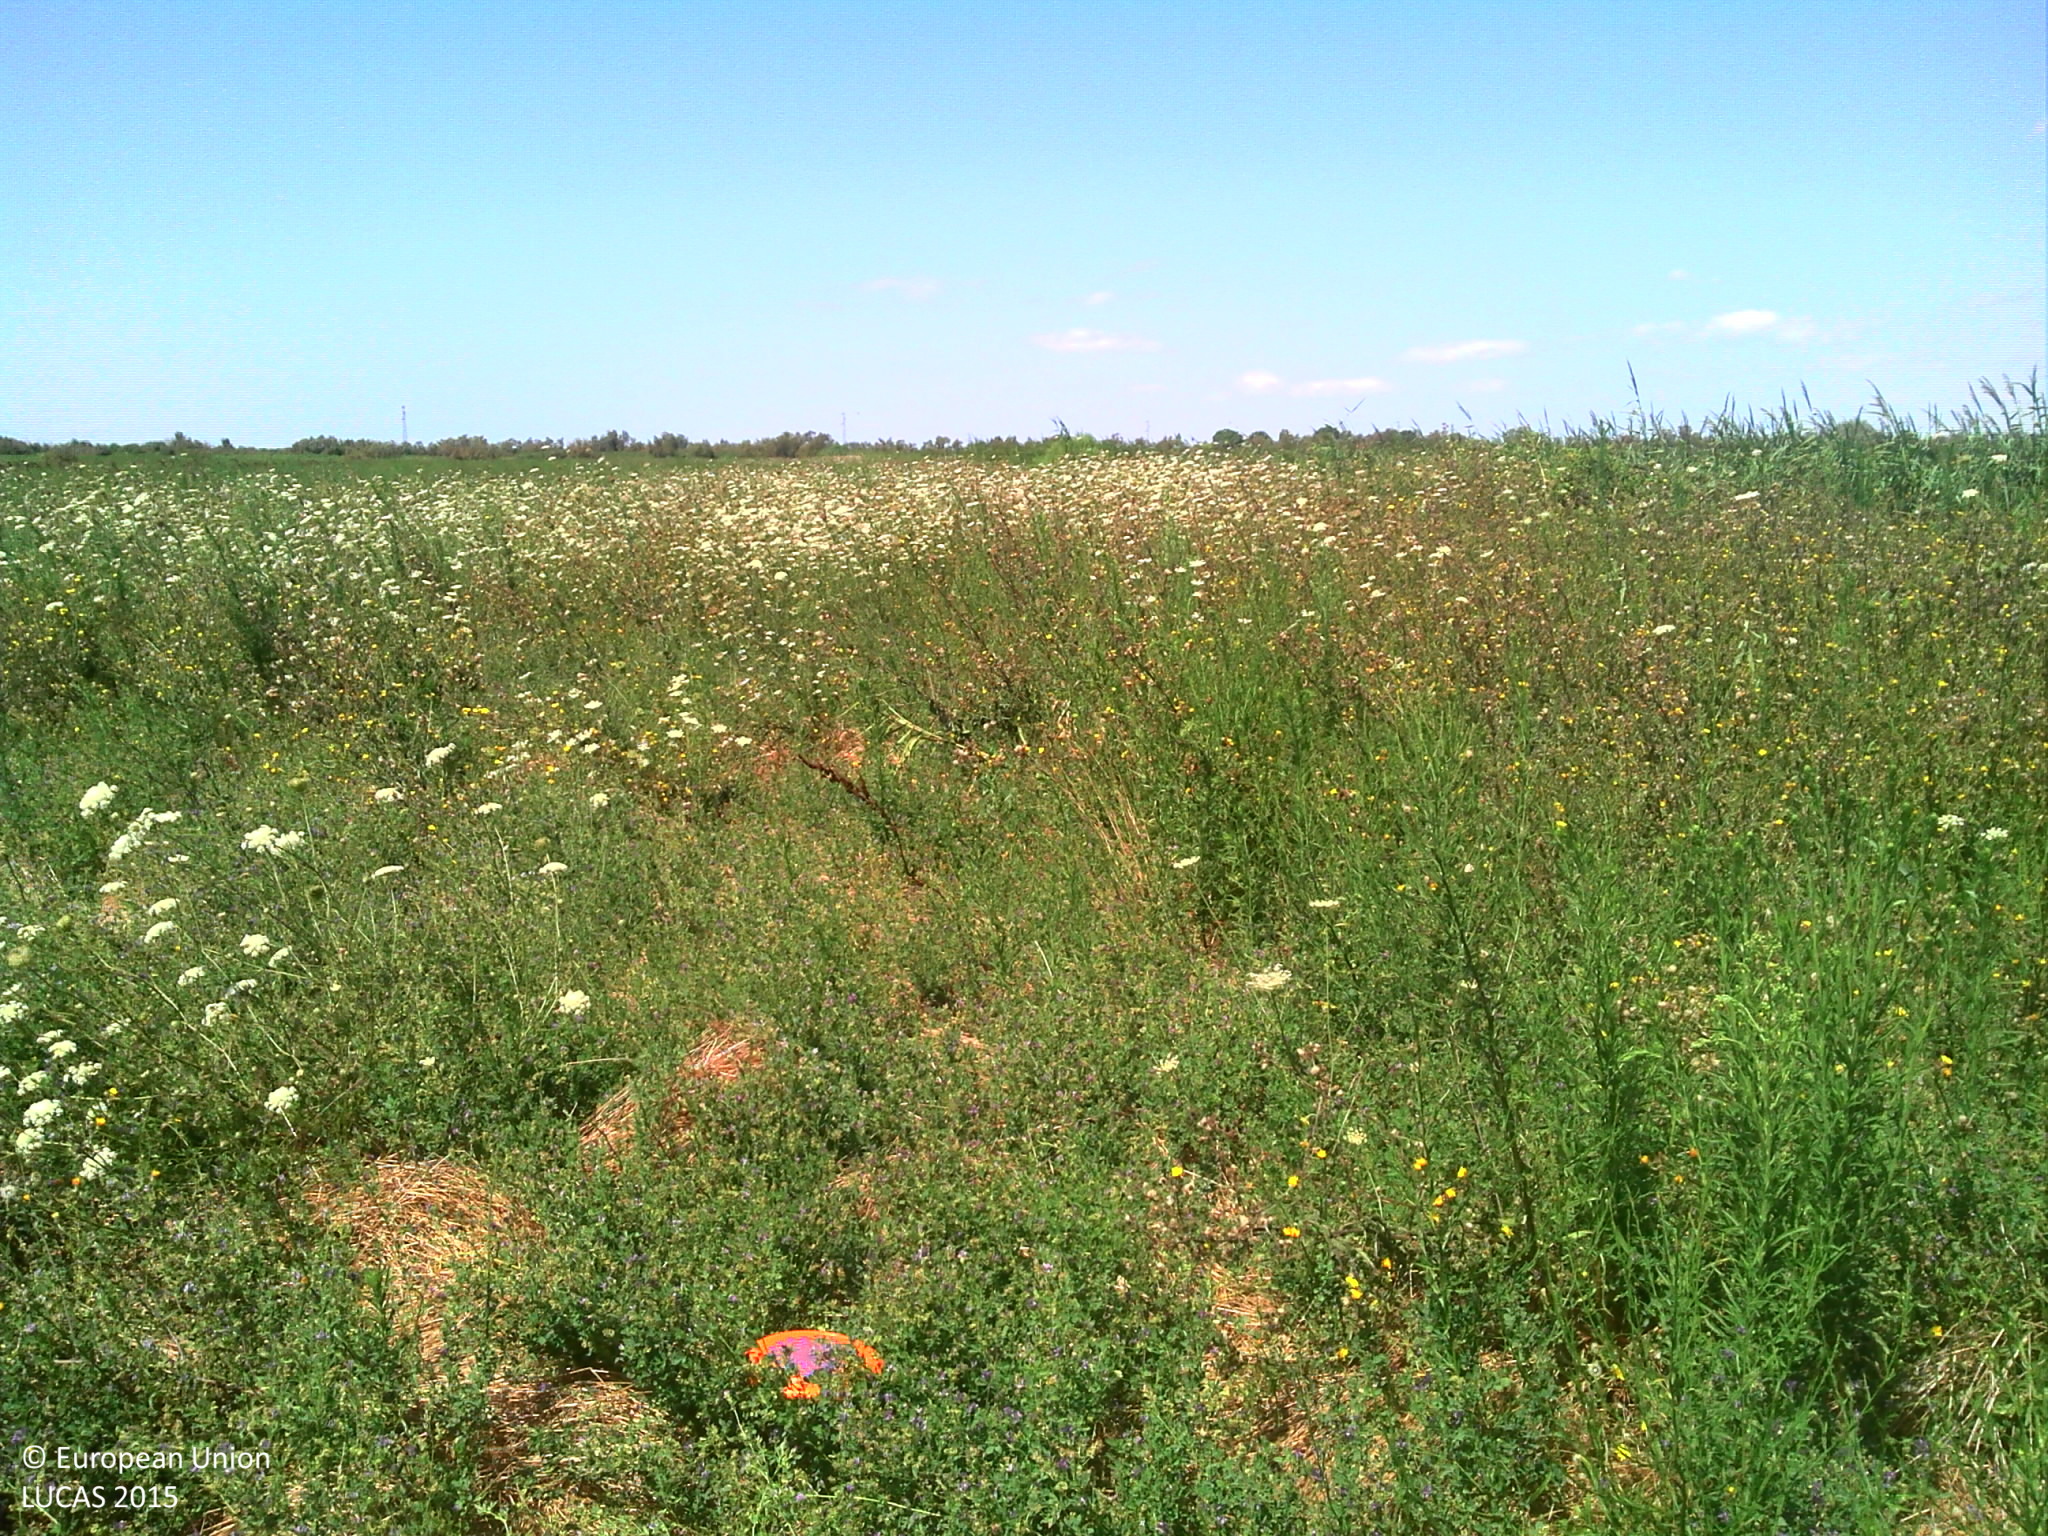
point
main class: Grassland
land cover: Grassland without tree/shrub cover
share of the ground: > 75 %
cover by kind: herbaceous plants 100 %
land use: Agriculture (excluding fallow land and kitchen gardens)
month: July
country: FR
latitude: 43.4743
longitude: 4.7067
